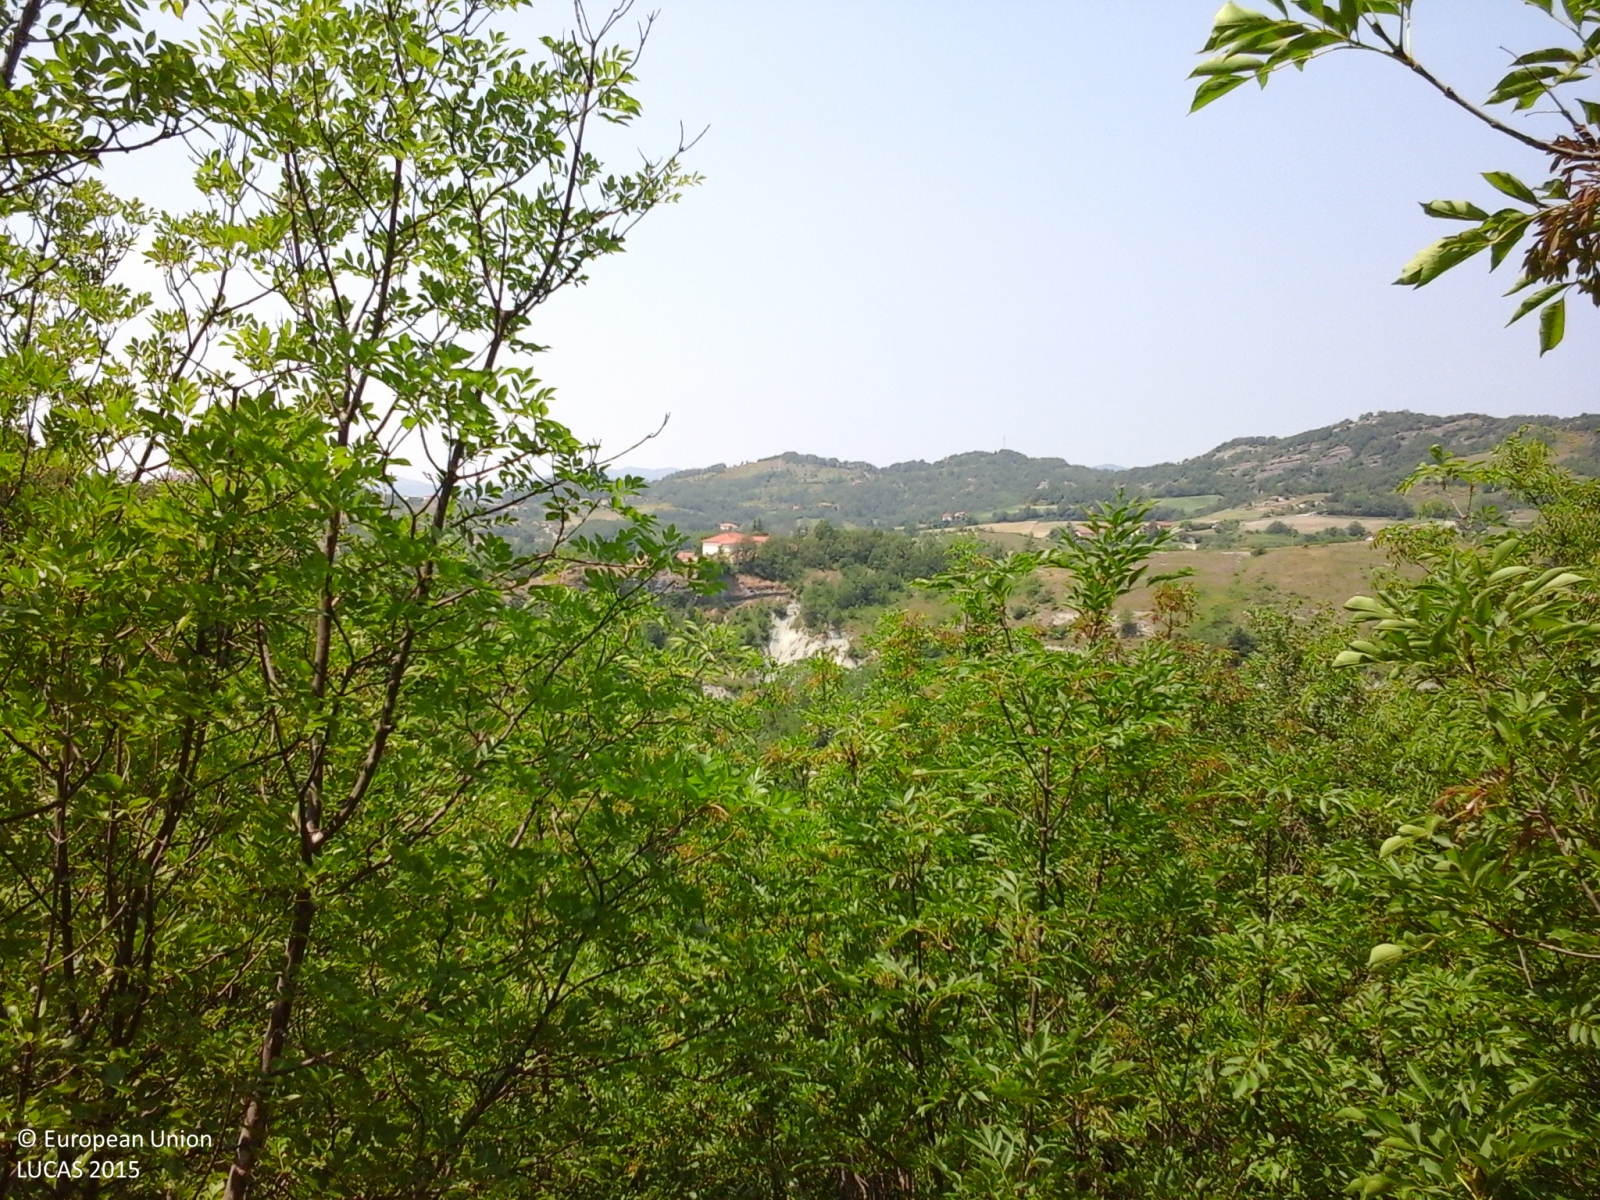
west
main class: Woodland
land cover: Broadleaved woodland
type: thermophilous deciduous forest
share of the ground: 50 - 75 %
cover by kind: broadleaved forest trees 70 %, shrubs 20 %, herbaceous plants 10 %
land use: Forestry
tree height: < 5 m
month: June
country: IT
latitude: 44.5187
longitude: 8.4056
